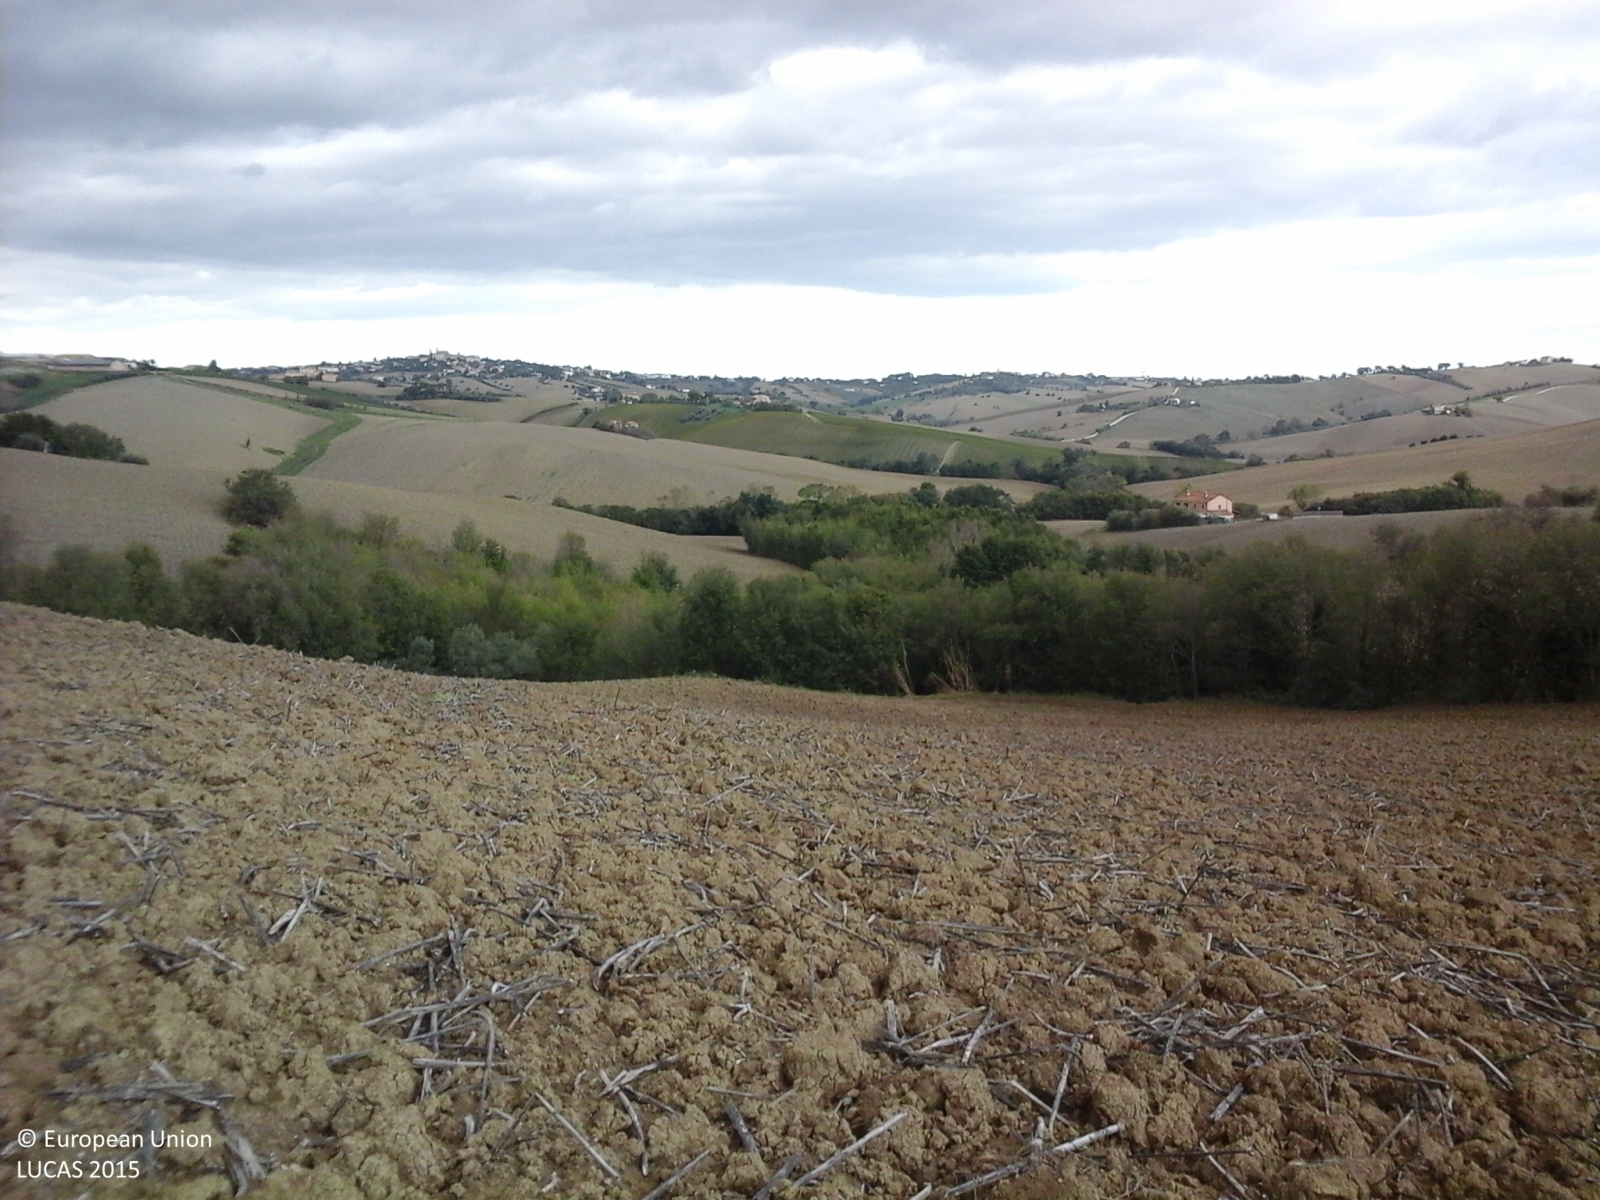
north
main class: Cropland
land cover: Sunflower
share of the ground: < 10 %
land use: Agriculture (excluding fallow land and kitchen gardens)
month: October
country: IT
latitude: 43.5438
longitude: 13.1729
